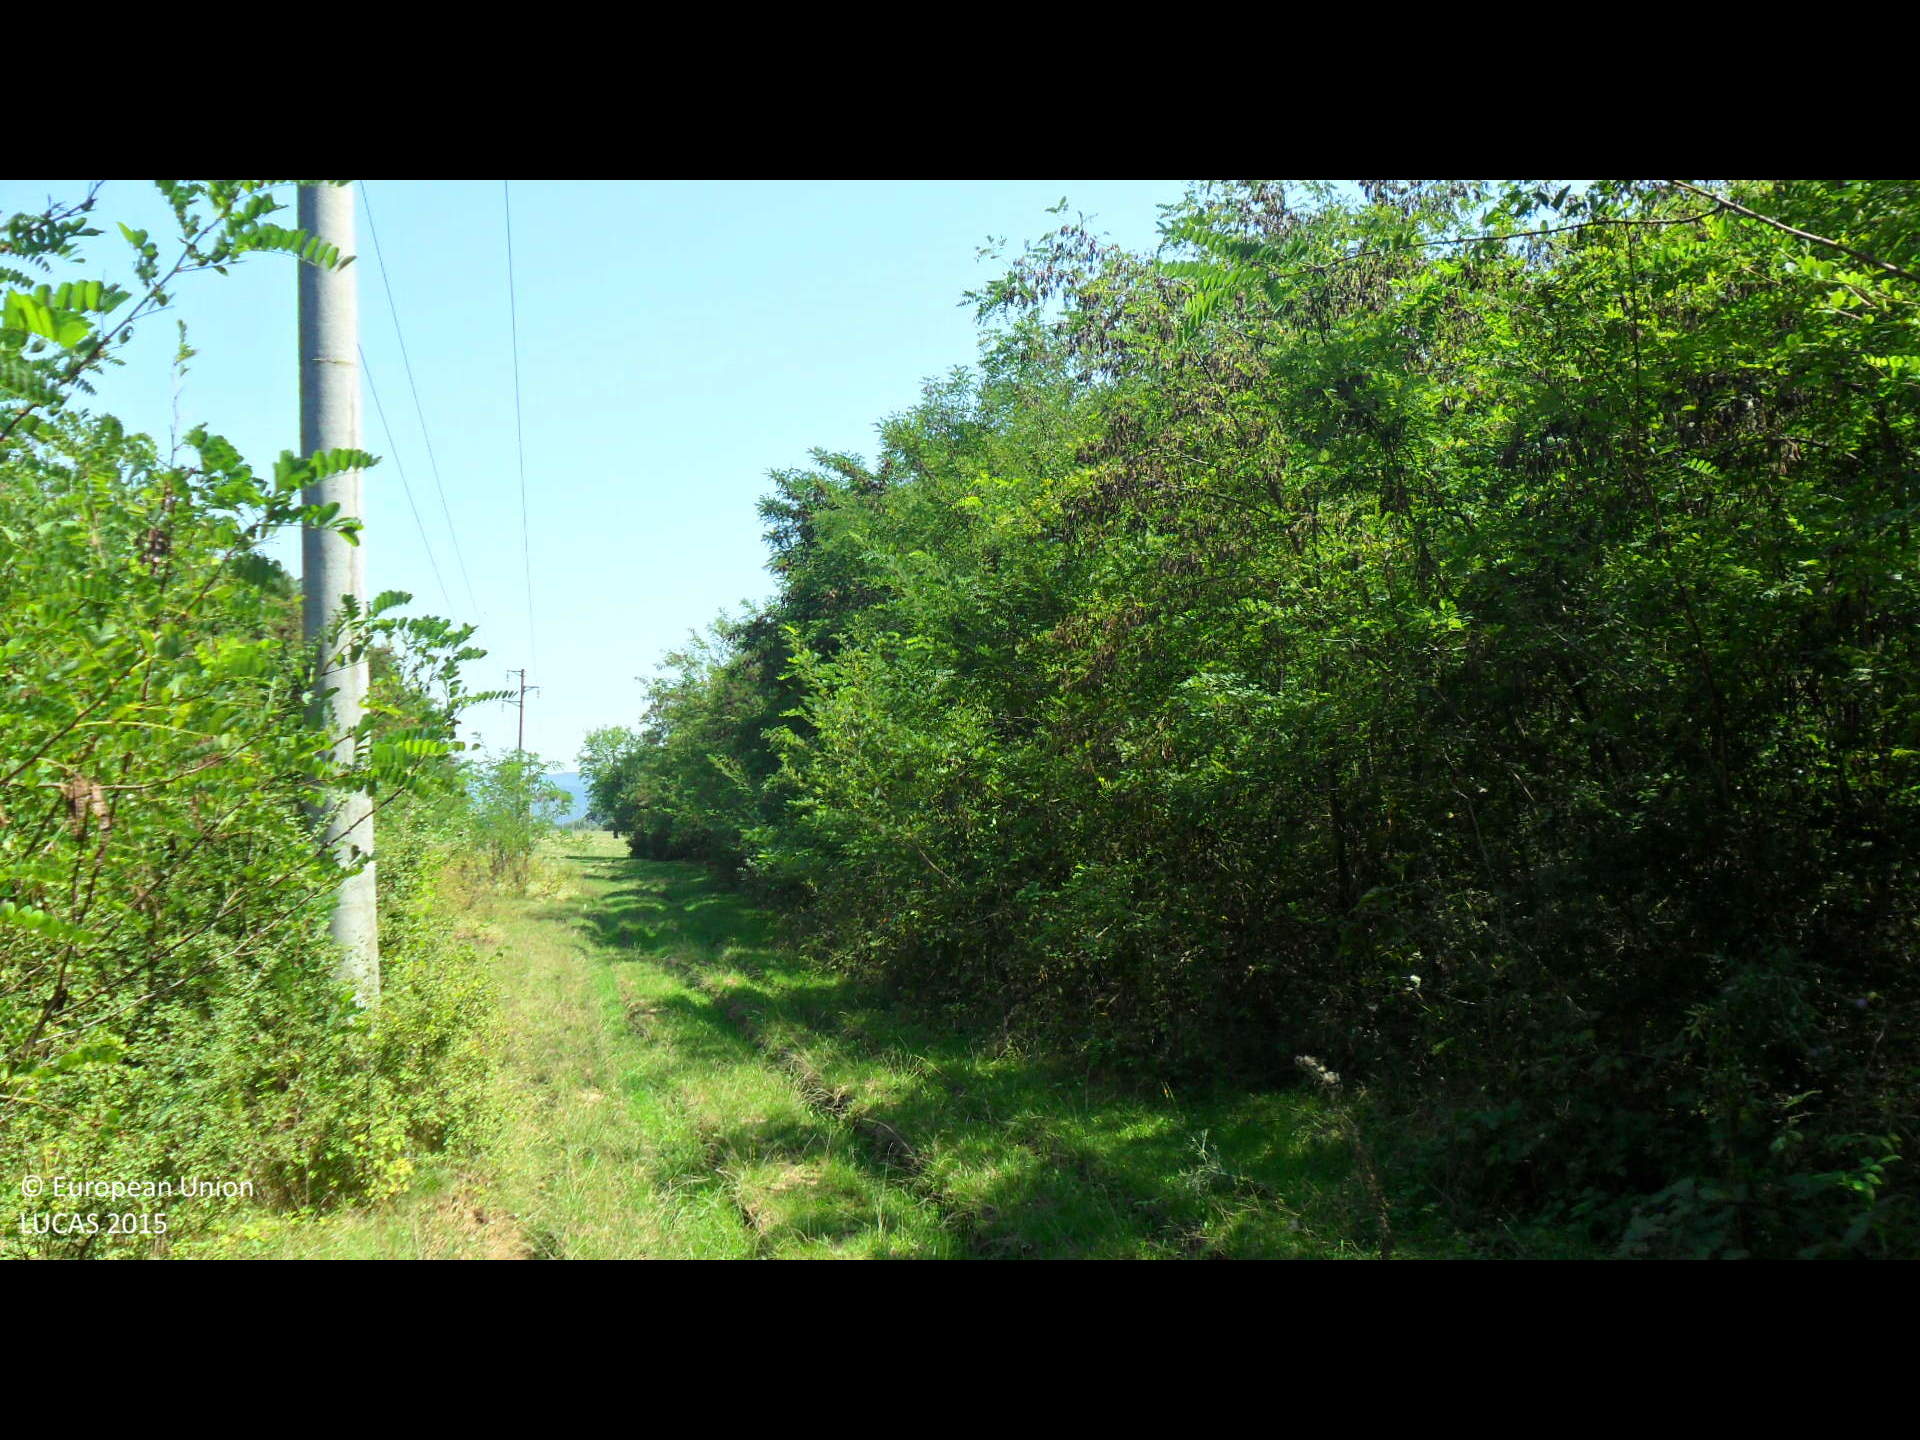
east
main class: Woodland
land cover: Broadleaved woodland
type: mesophytic deciduous forest
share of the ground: > 75 %
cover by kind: broadleaved forest trees 100 %
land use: Forestry
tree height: > 5 m
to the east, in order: Broadleaved woodland; Grassland with sparse tree/shrub cover
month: August
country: BG
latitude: 43.2223
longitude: 26.7144
